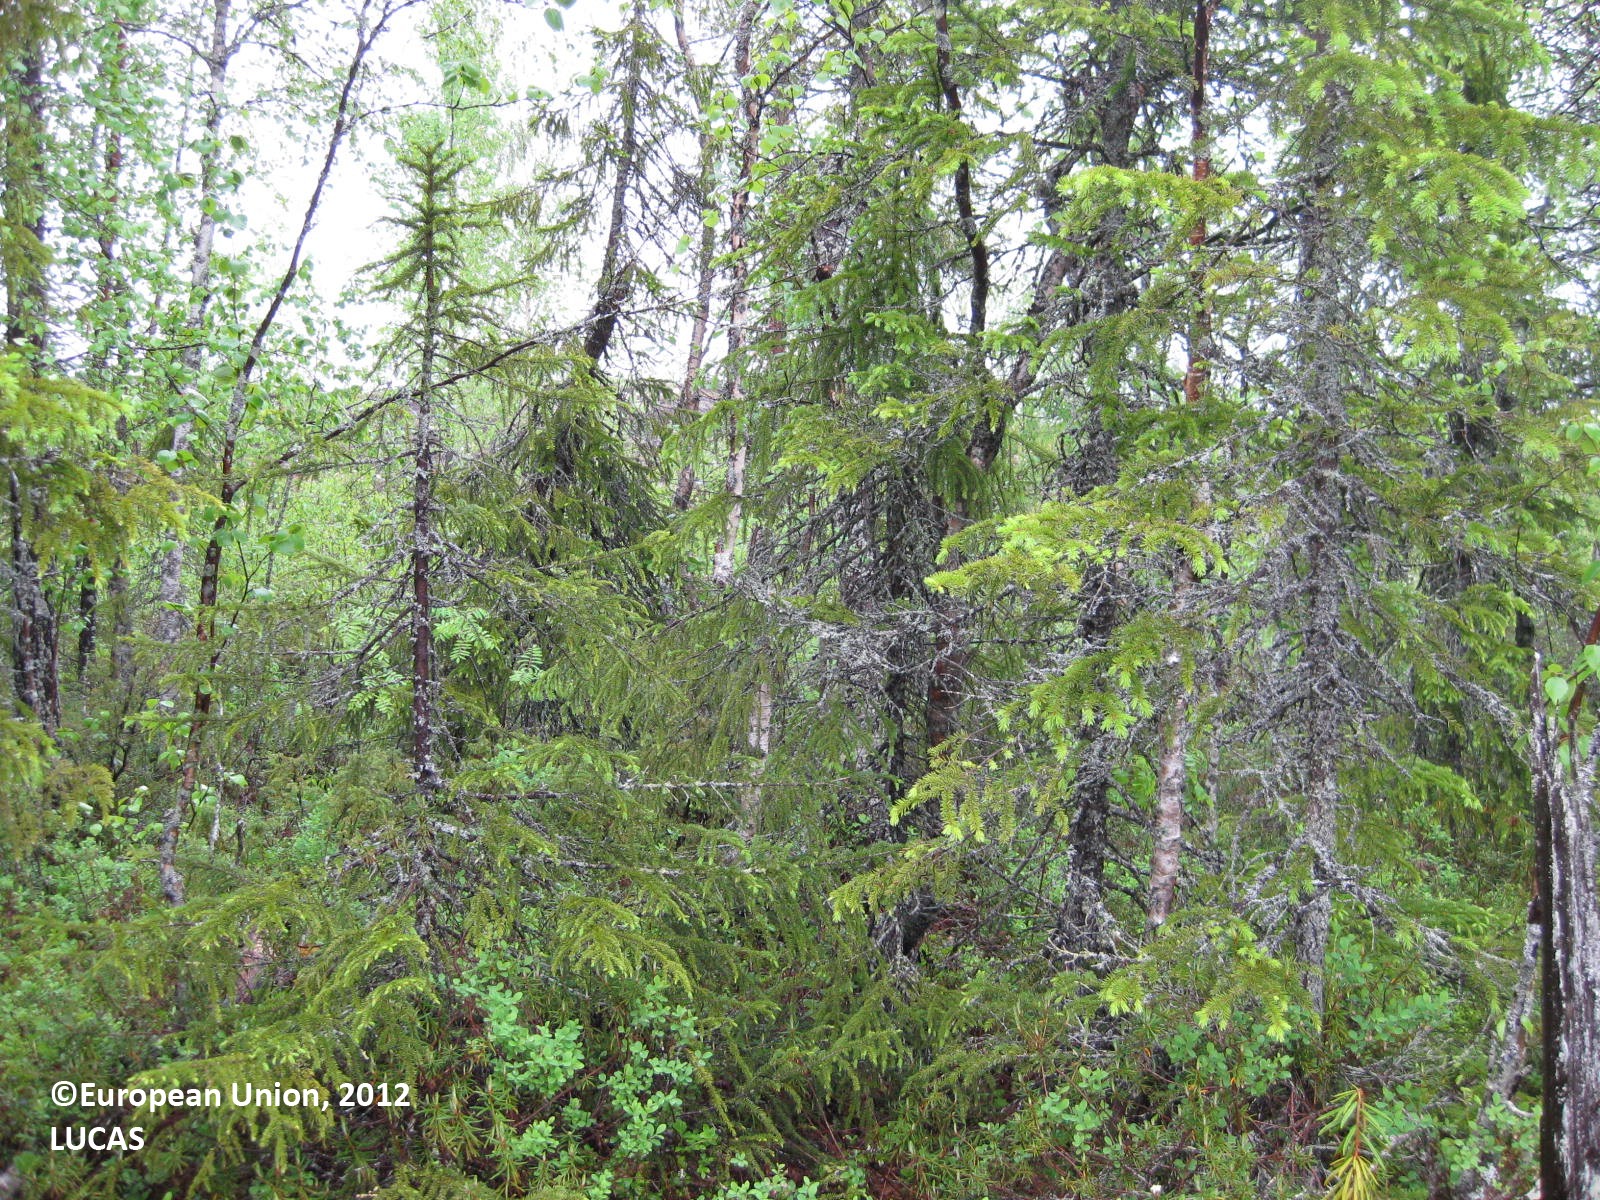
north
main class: Woodland
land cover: Pine dominated mixed woodland
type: boreal forest
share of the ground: 50 - 75 %
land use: Forestry
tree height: > 5 m
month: June
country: FI
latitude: 65.2758
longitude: 28.9740
